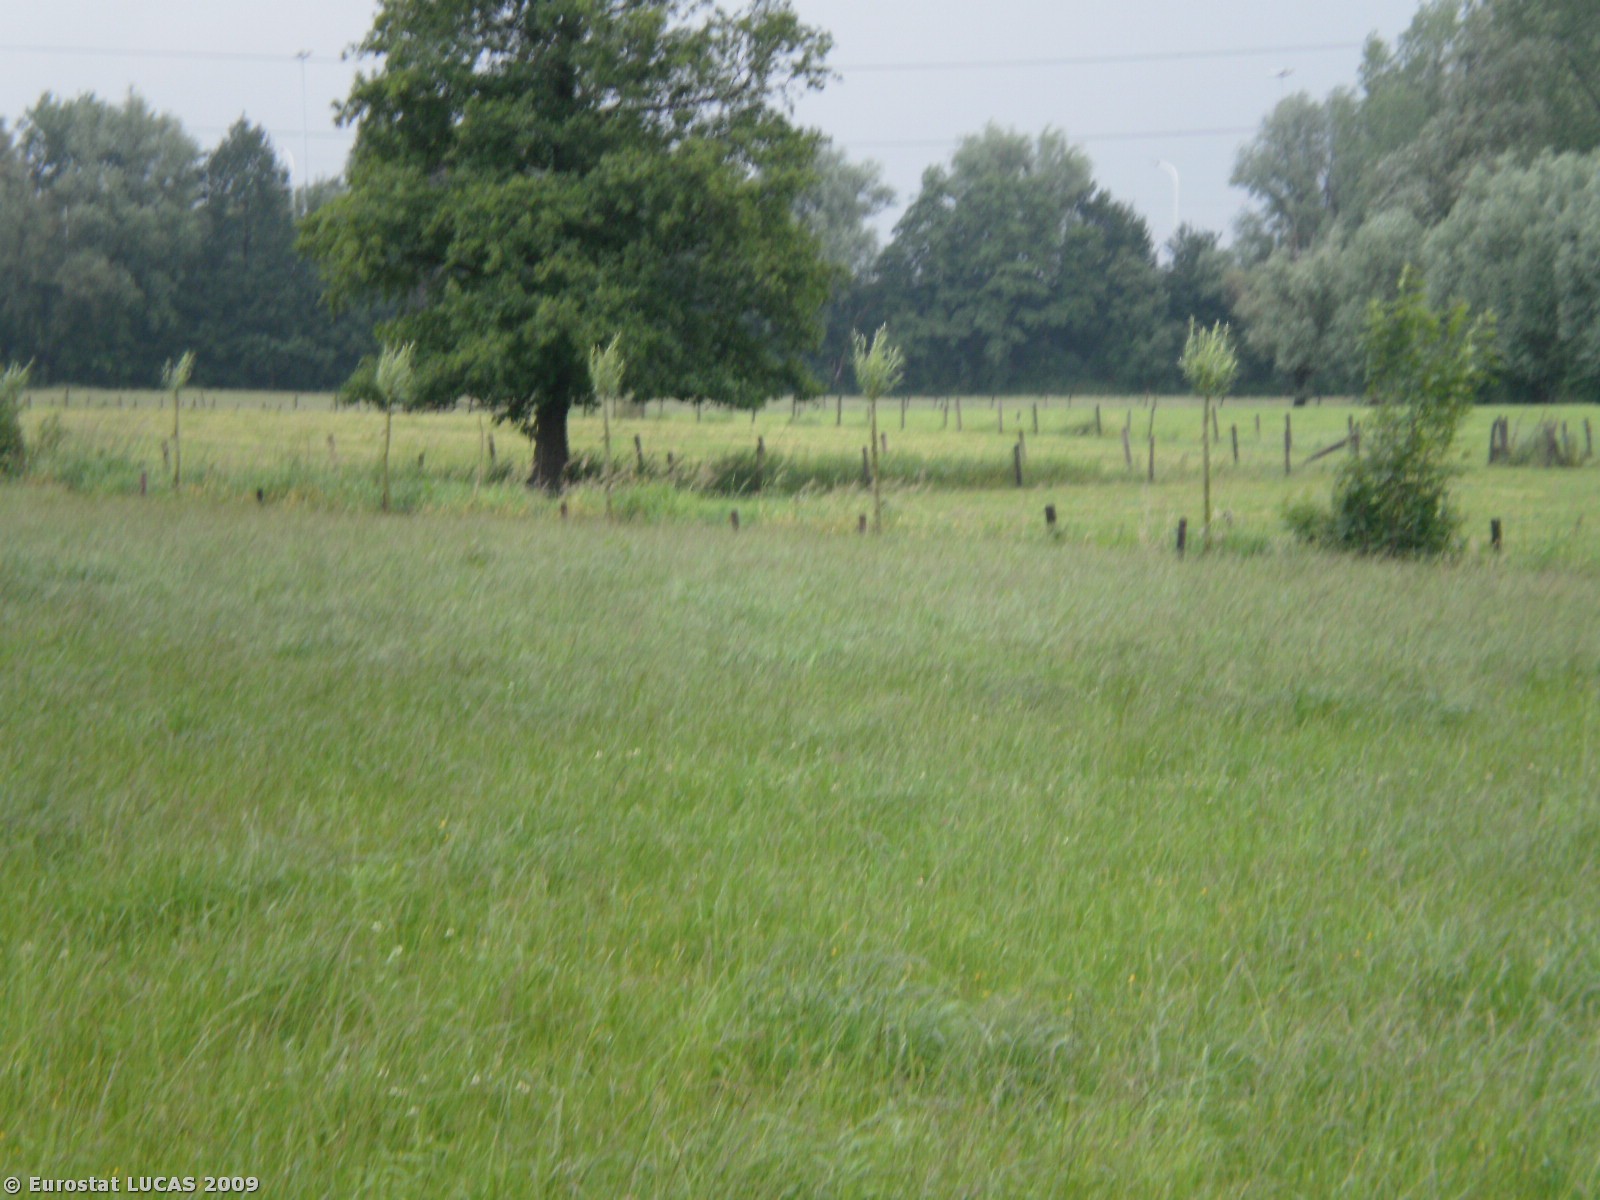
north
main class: Grassland
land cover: Grassland without tree/shrub cover
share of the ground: > 75 %
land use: Agriculture (excluding fallow land and kitchen gardens)
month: June
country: BE
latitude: 51.1337
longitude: 4.1496
